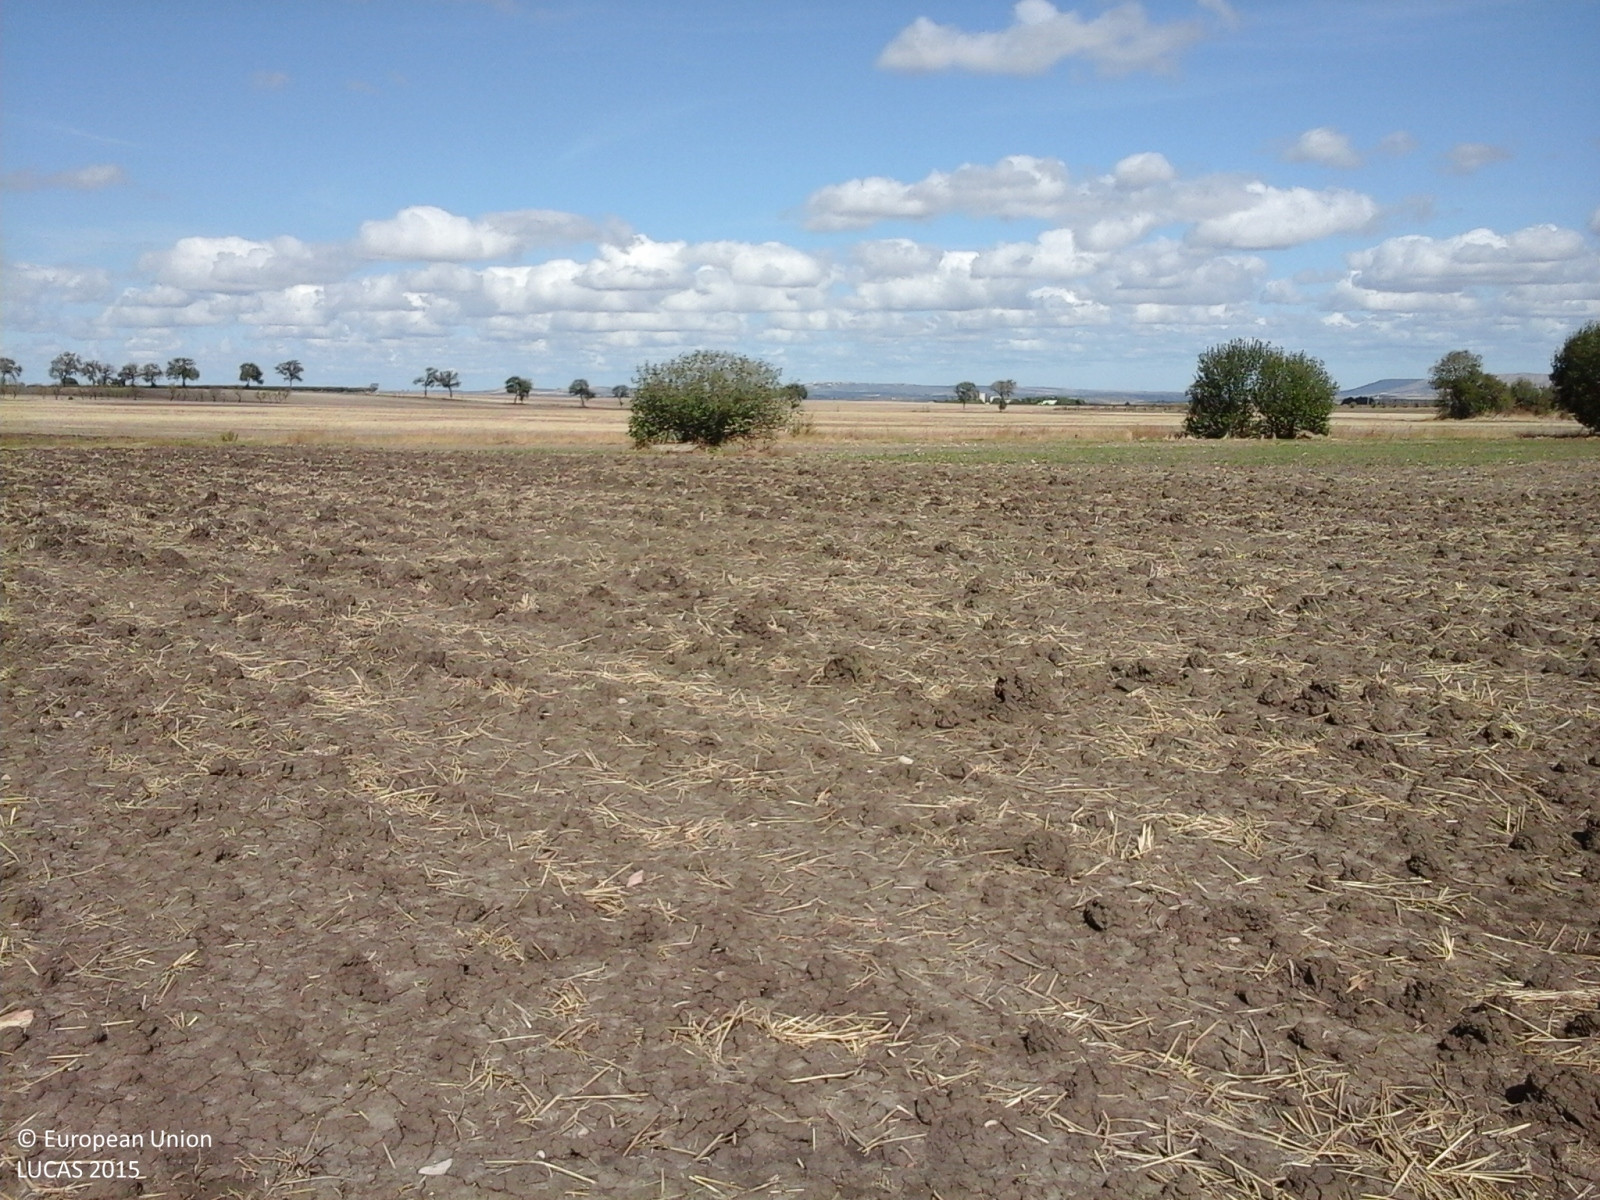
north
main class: Cropland
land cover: Durum wheat
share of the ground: > 75 %
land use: Agriculture (excluding fallow land and kitchen gardens)
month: September
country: IT
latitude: 41.6357
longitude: 15.1571
